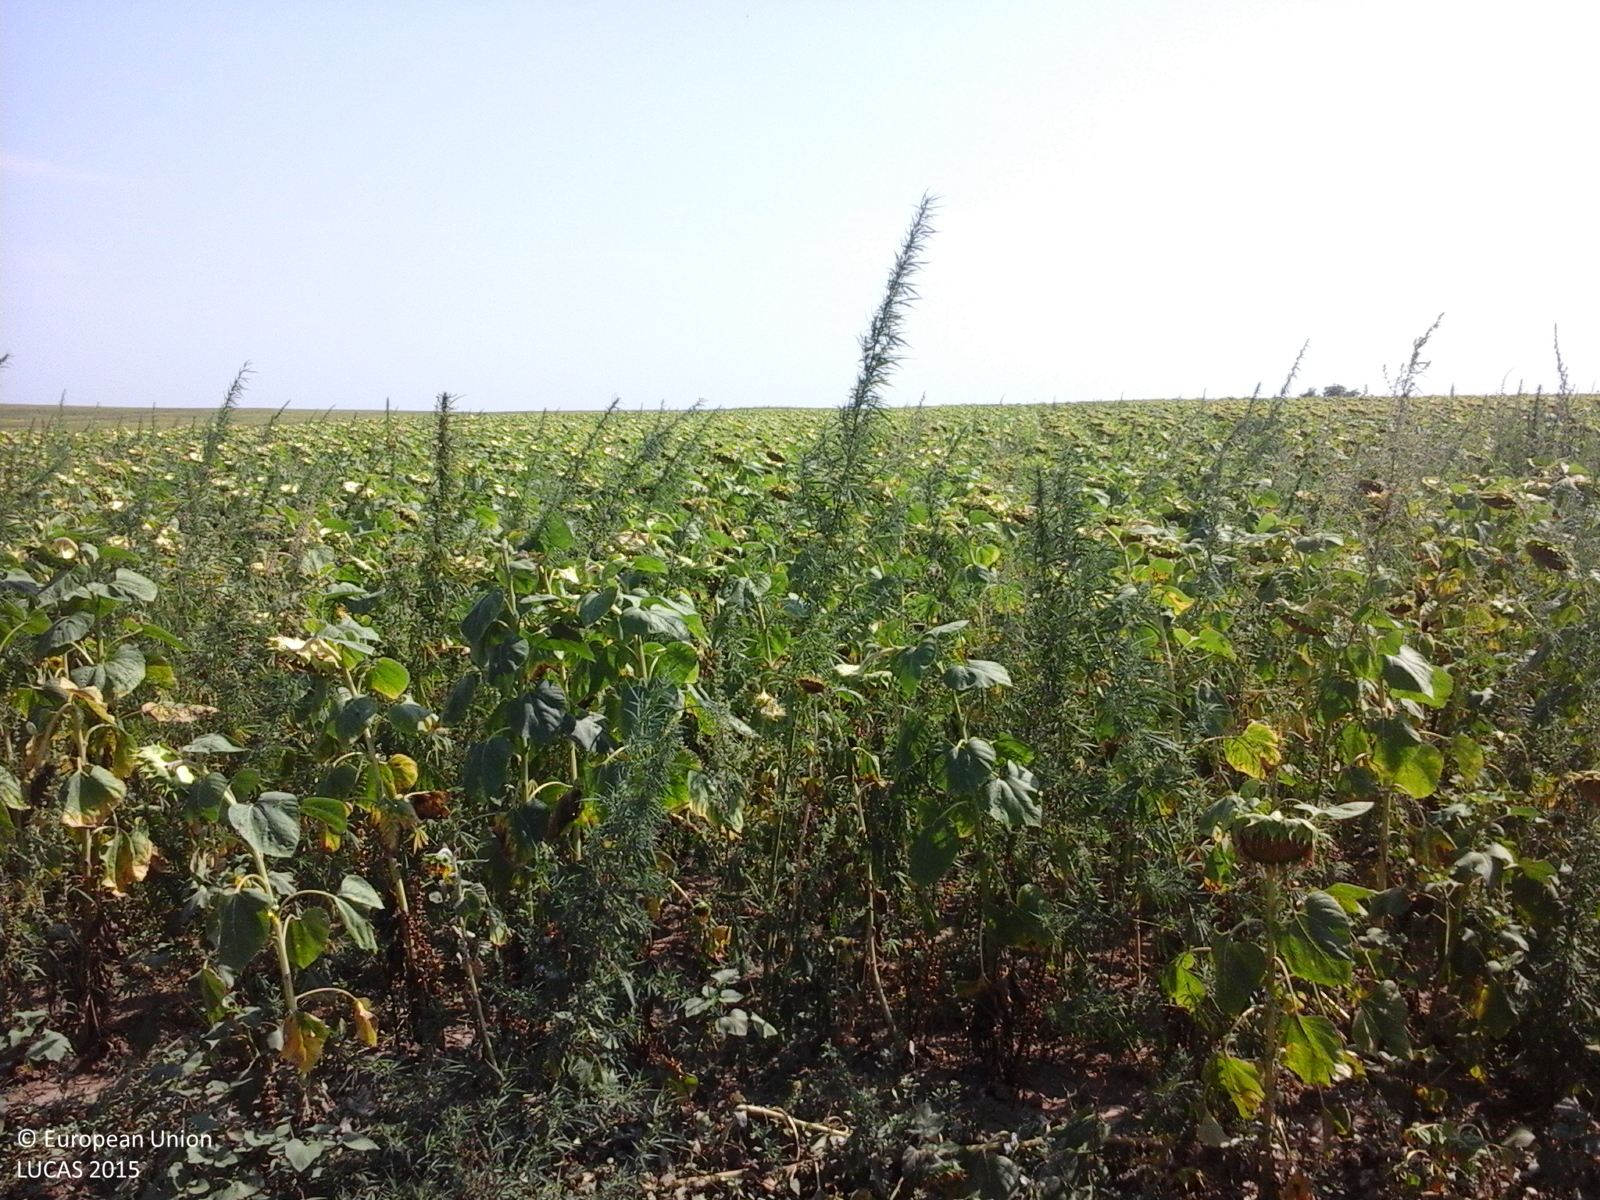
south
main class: Cropland
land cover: Sunflower
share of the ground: > 75 %
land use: Agriculture (excluding fallow land and kitchen gardens)
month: August
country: RO
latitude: 44.1800
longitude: 28.0042
